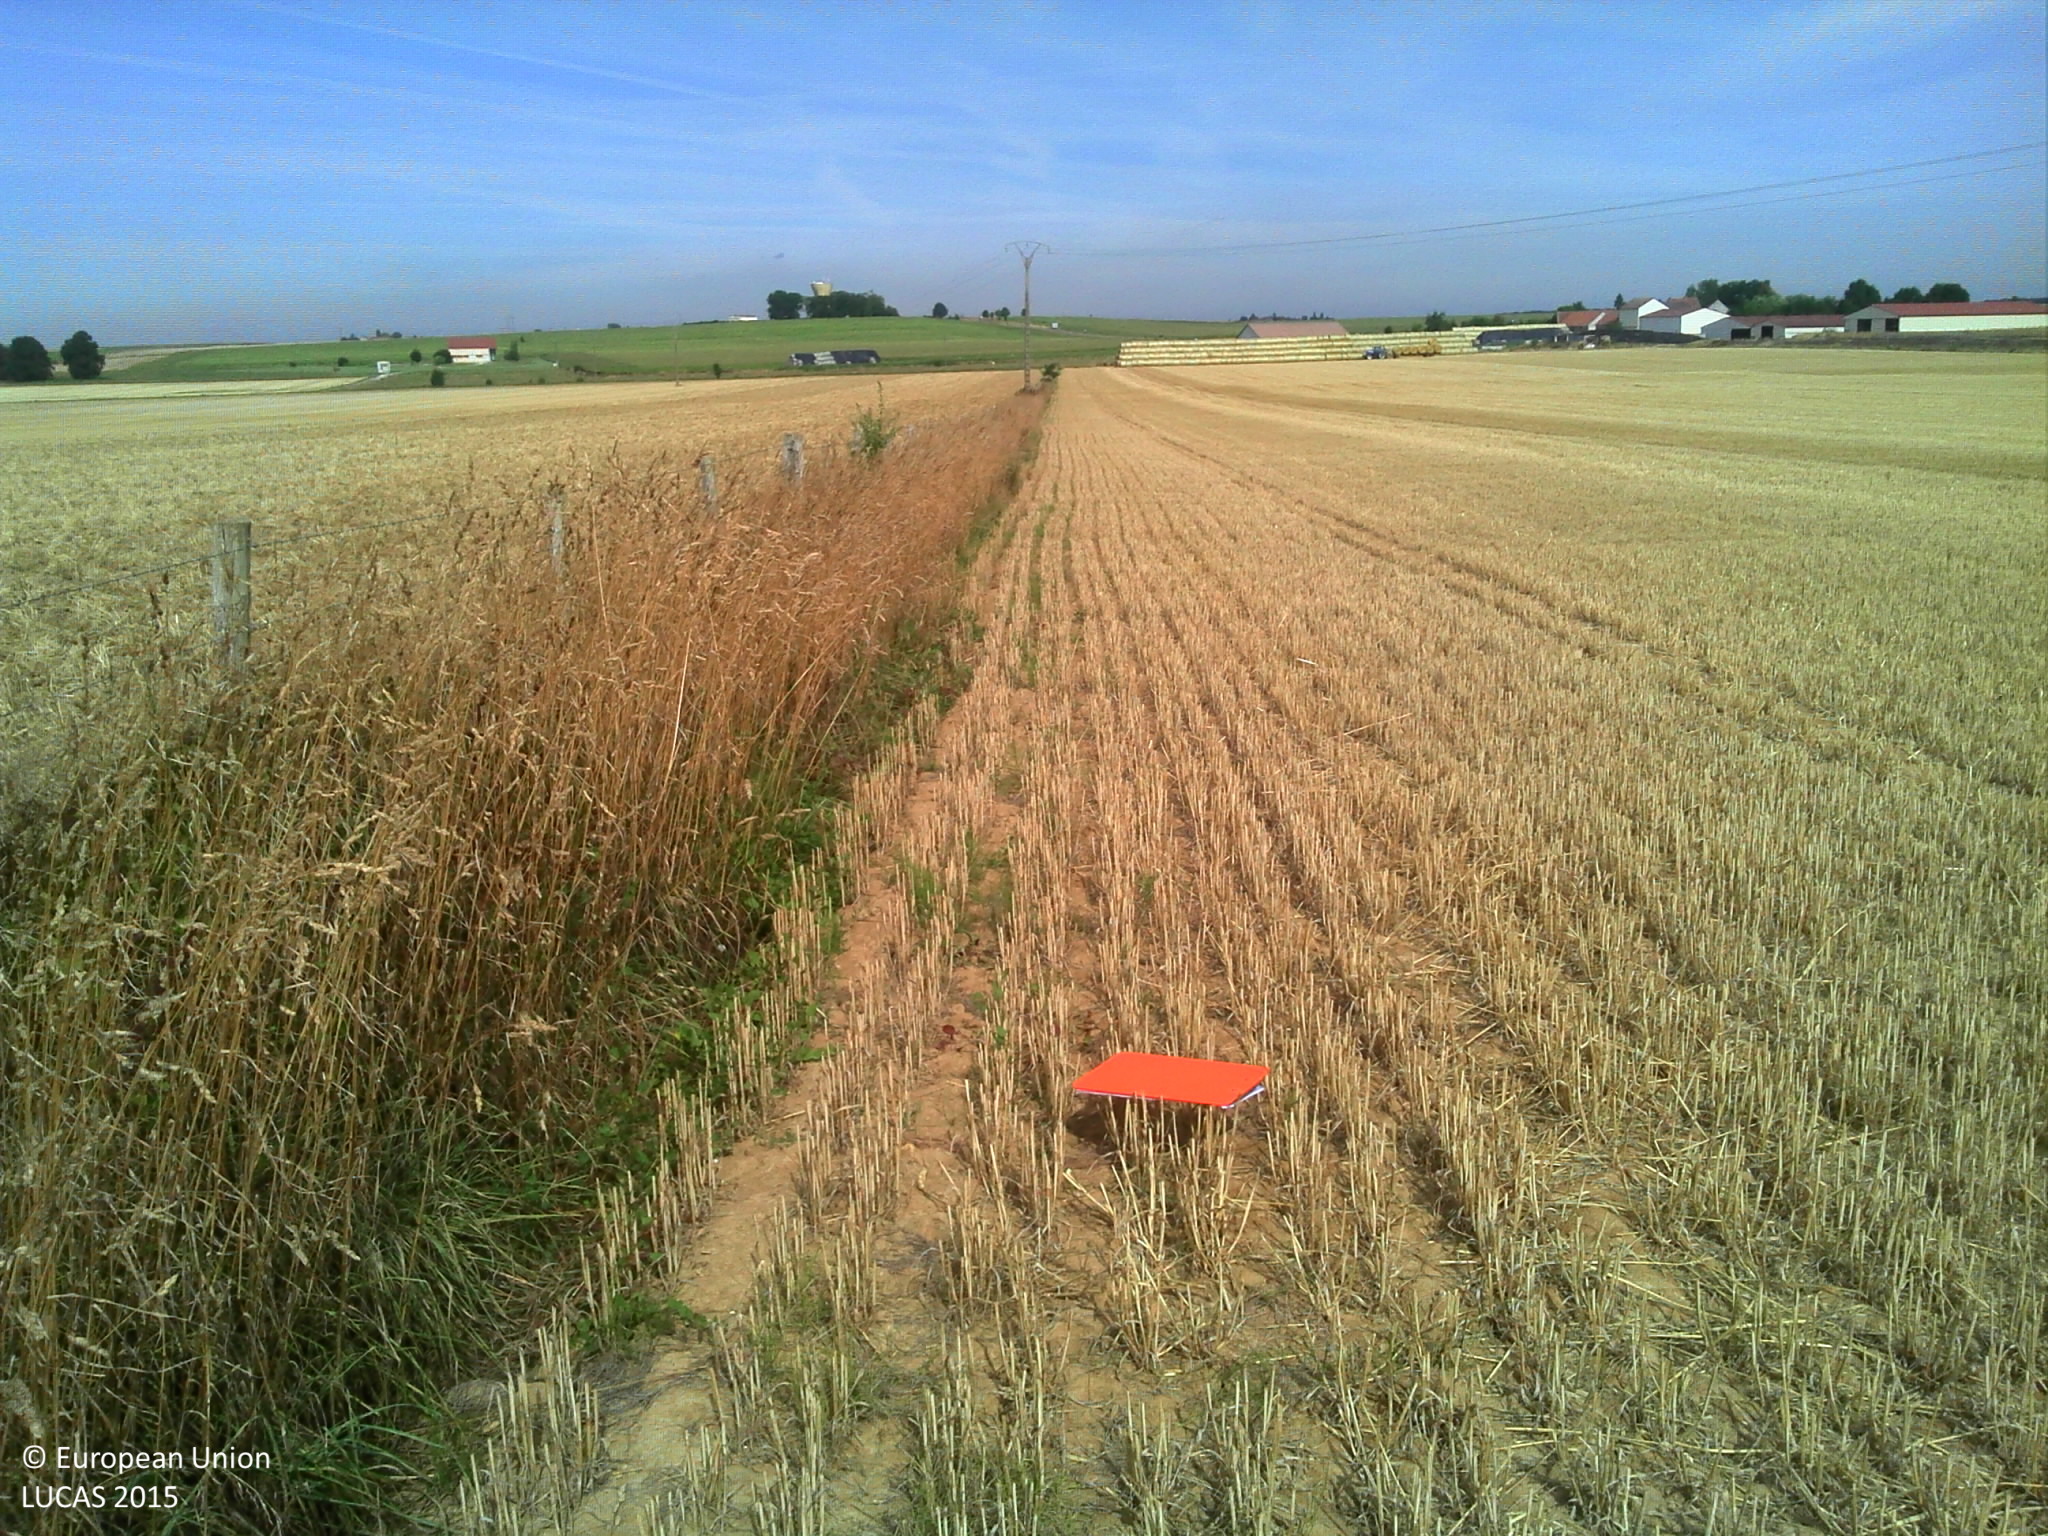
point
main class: Cropland
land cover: Common wheat
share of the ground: > 75 %
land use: Agriculture (excluding fallow land and kitchen gardens)
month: August
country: FR
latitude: 48.9055
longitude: 3.3212
